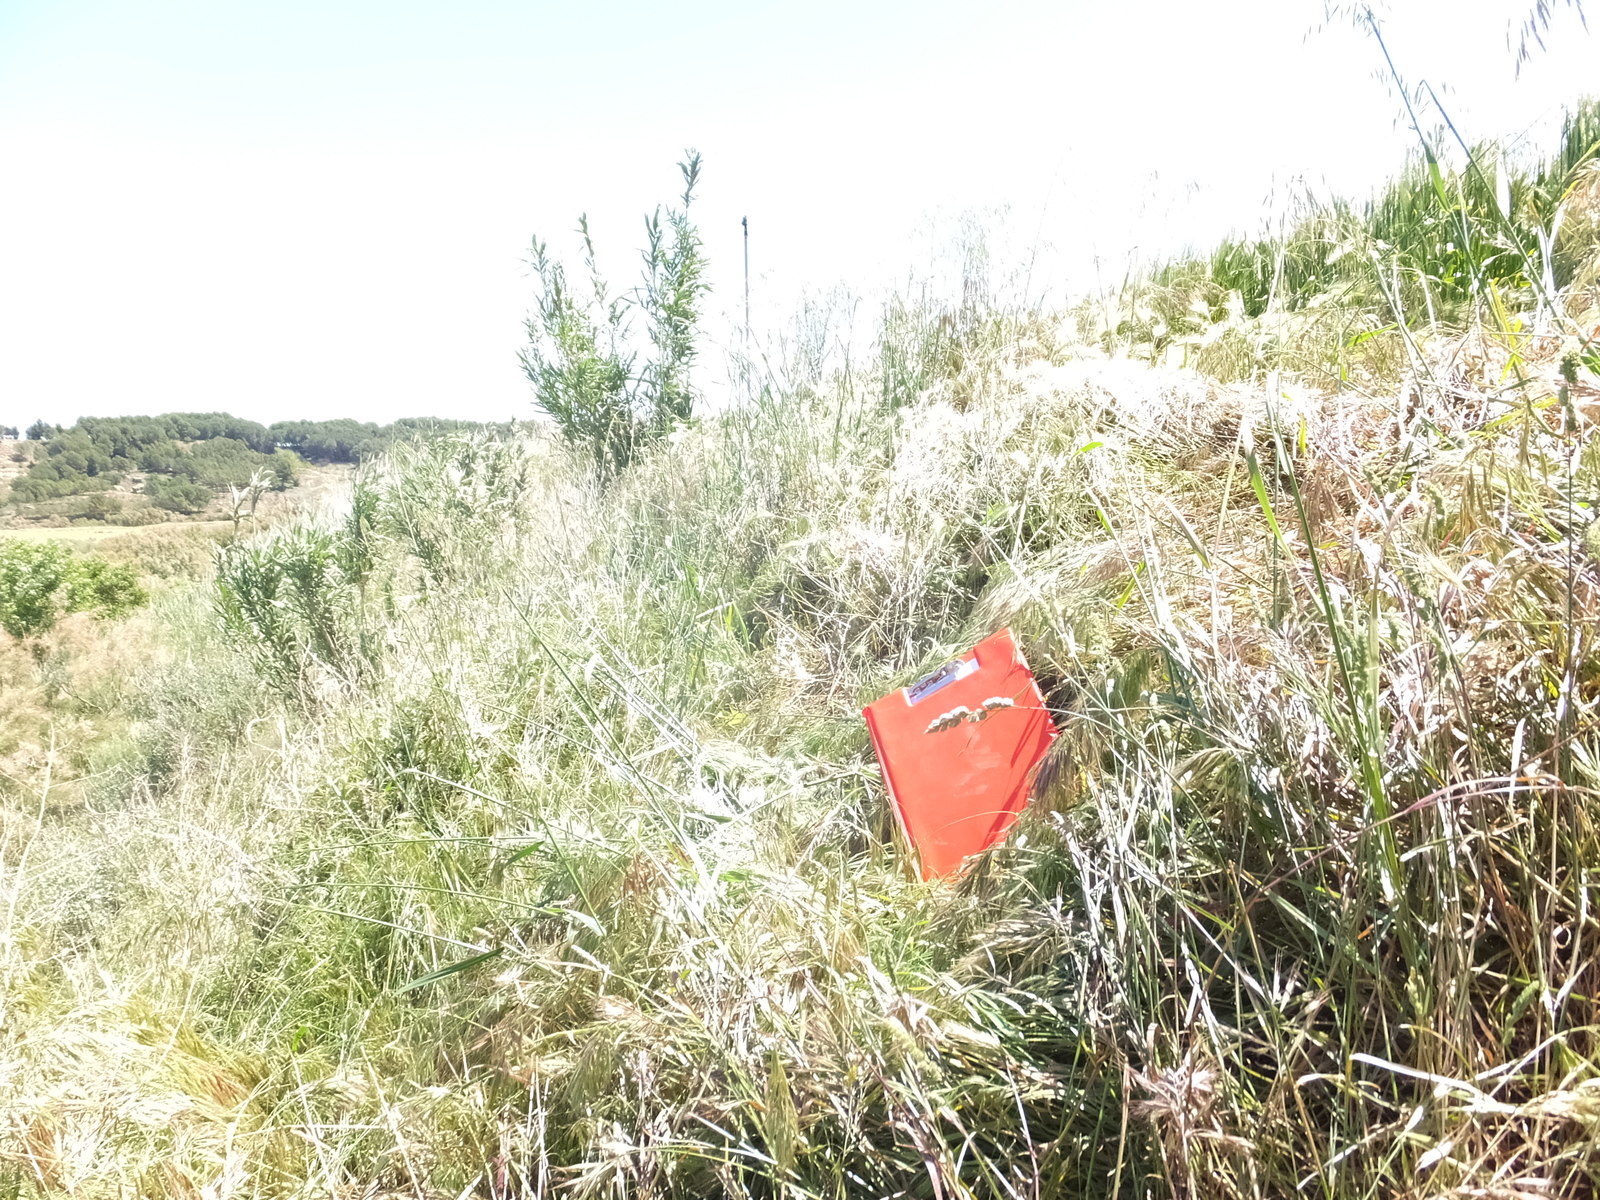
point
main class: Grassland
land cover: Spontaneously vegetated surfaces
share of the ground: > 75 %
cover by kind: herbaceous plants 80 %, consolidated bare surface 15 %, shrubs 5 %
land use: Semi-natural and natural areas not in use
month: May
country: ES
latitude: 41.8089
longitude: -0.2137
